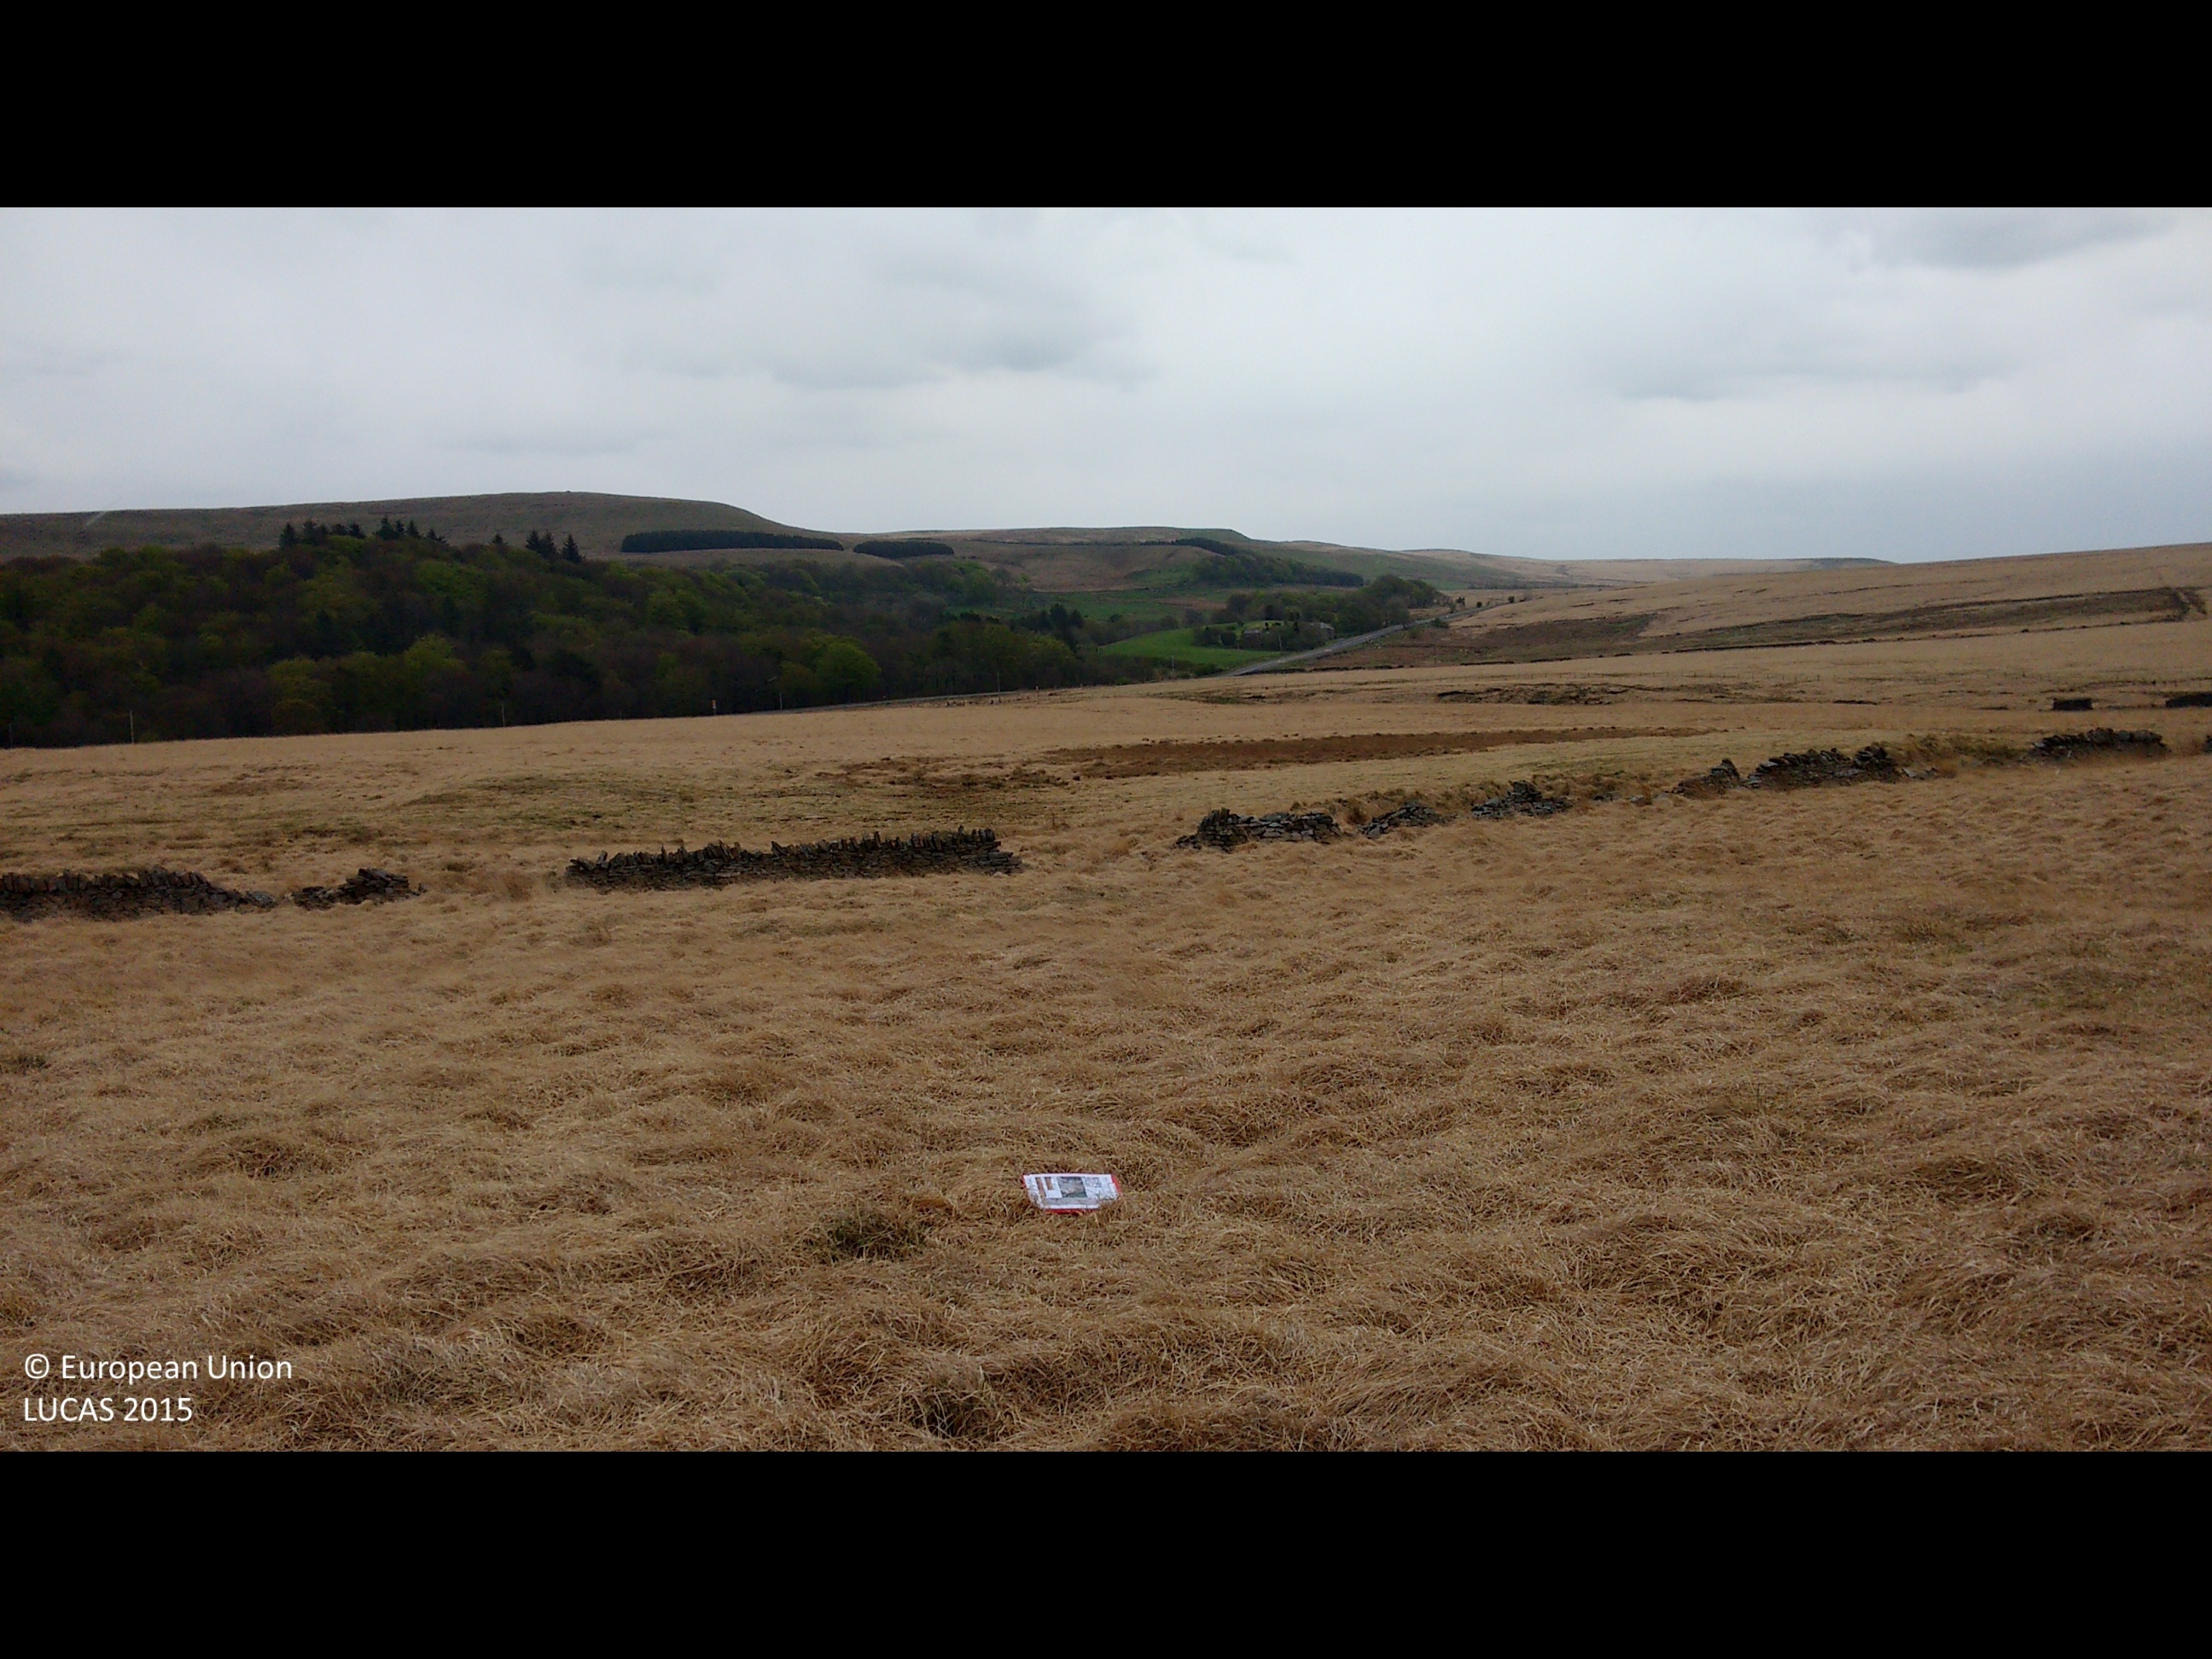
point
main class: Grassland
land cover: Grassland without tree/shrub cover
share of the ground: > 75 %
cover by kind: herbaceous plants 100 %
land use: Agriculture (excluding fallow land and kitchen gardens)
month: May
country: GB
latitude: 53.6769
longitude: -2.5247
